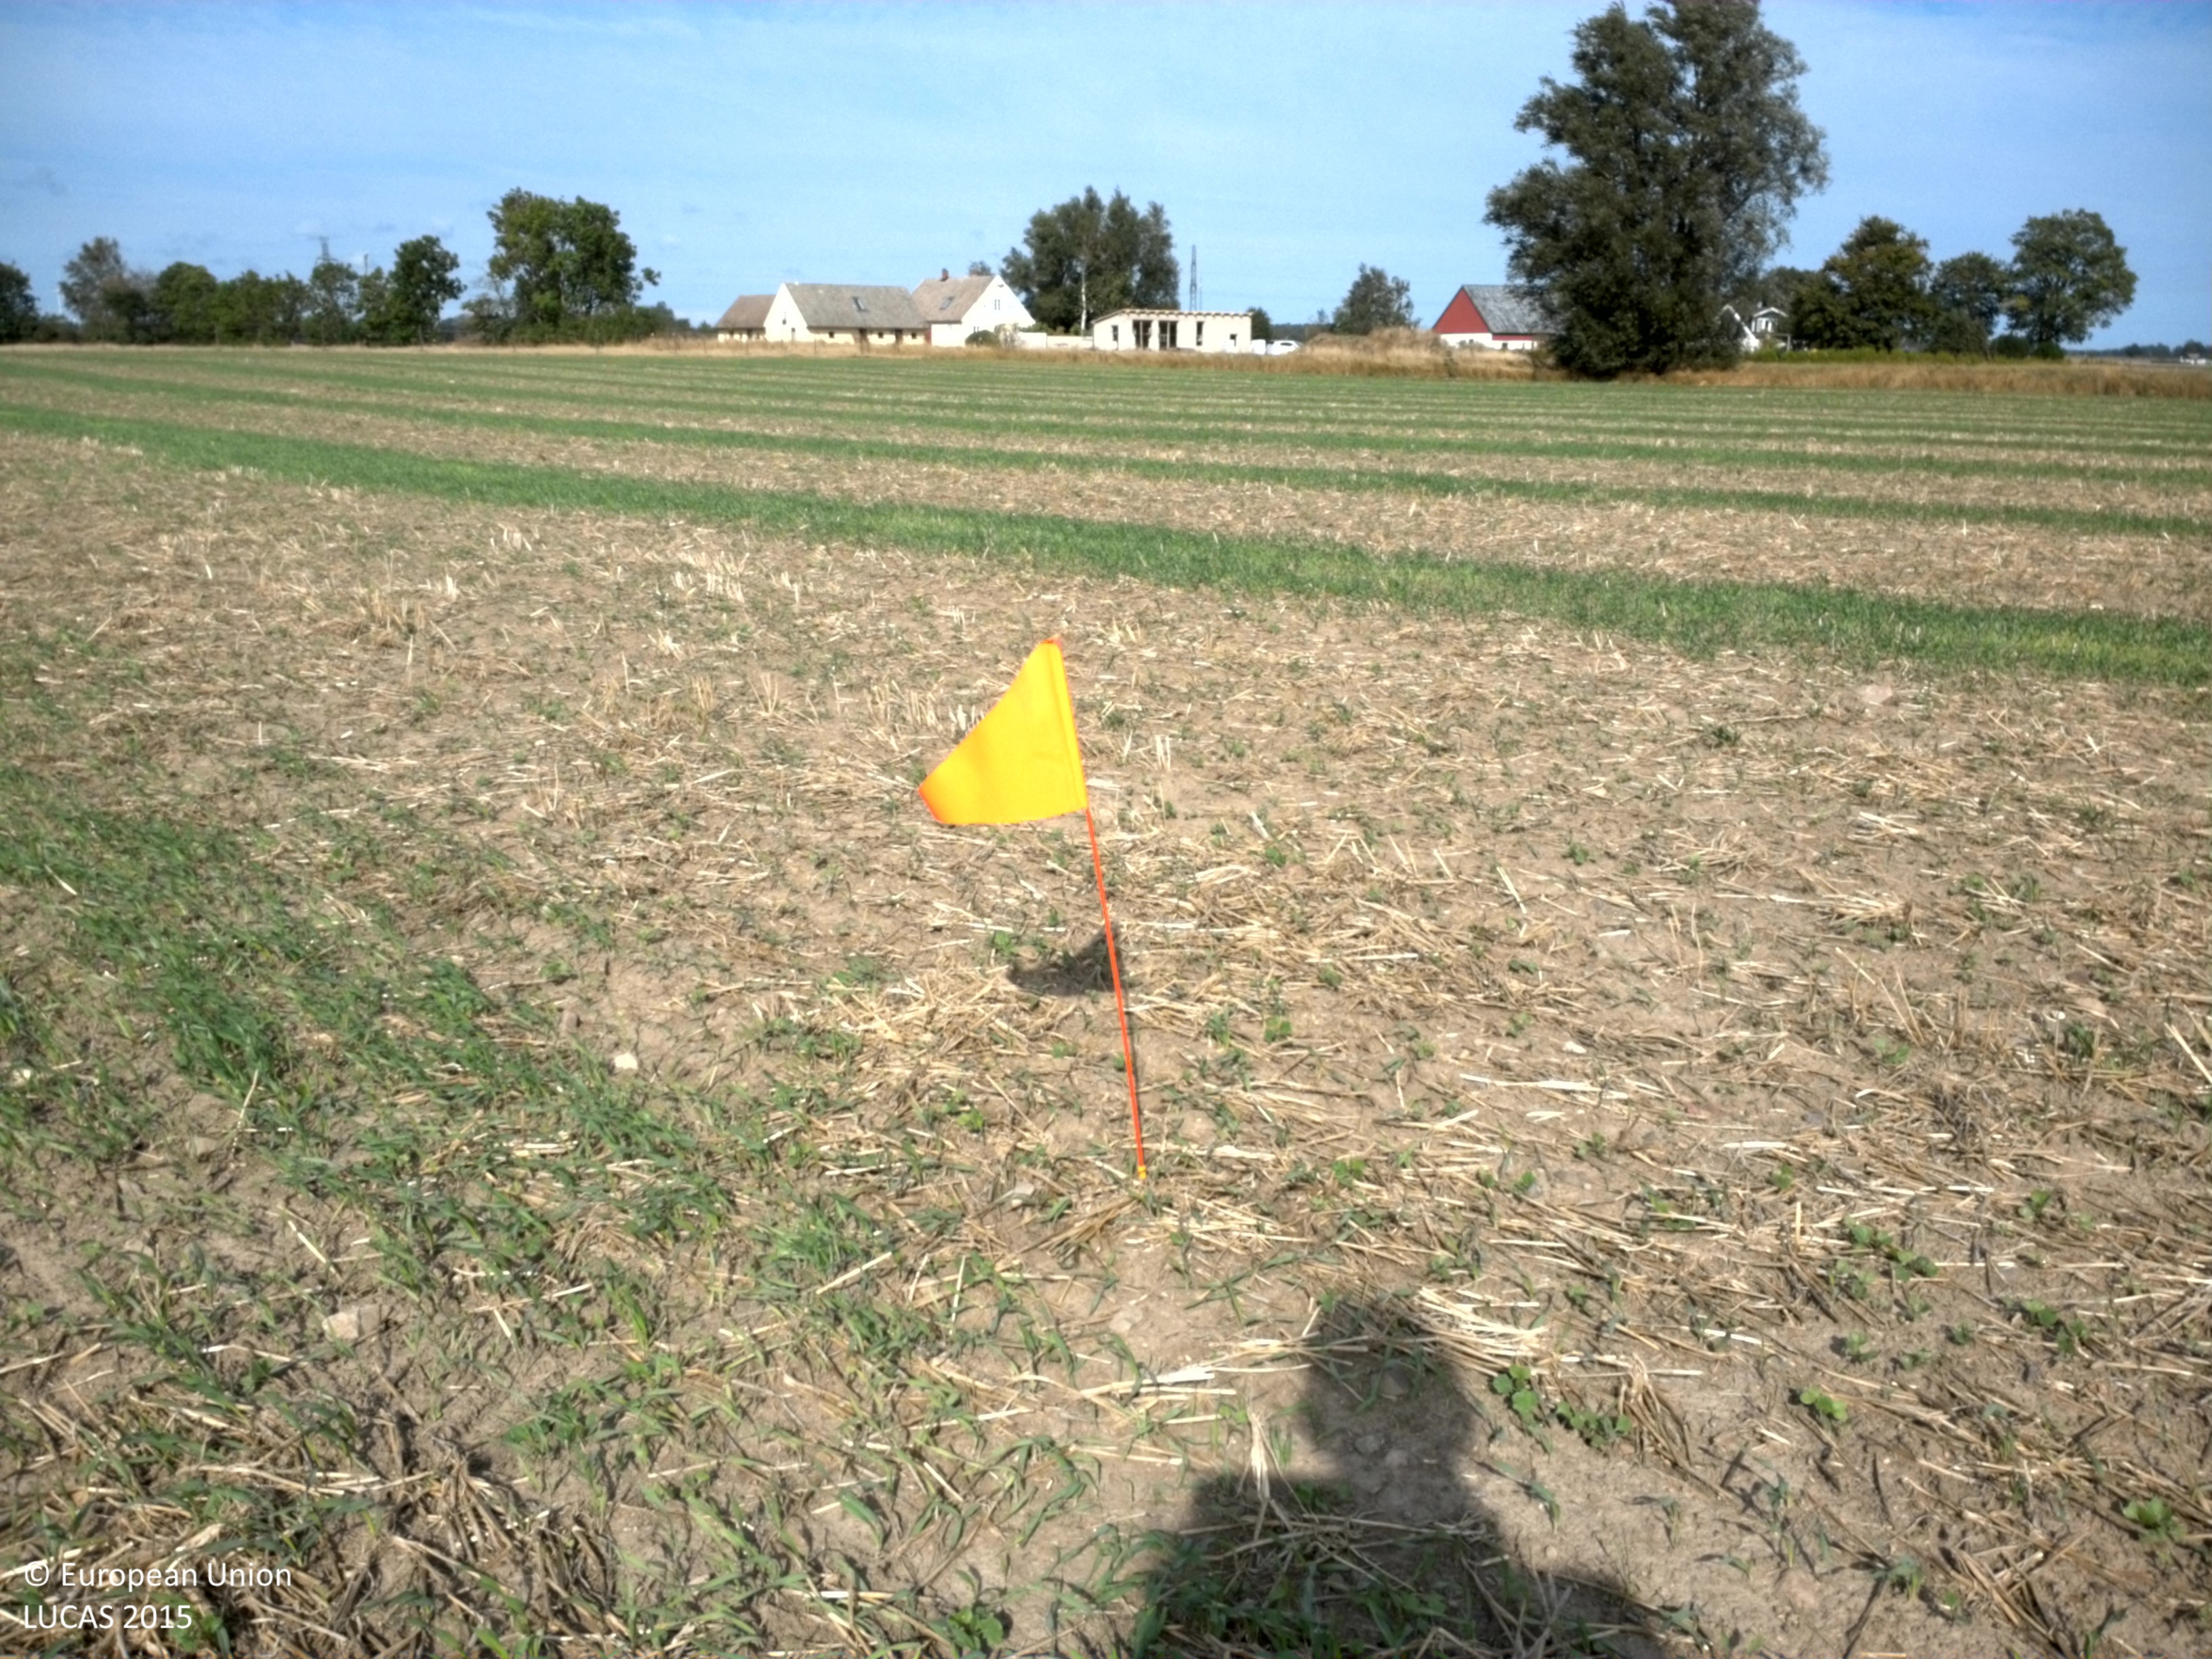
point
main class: Cropland
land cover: Other leguminous and mixtures for fodder
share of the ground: 10 - 25 %
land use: Agriculture (excluding fallow land and kitchen gardens)
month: September
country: SE
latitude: 55.5303
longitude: 14.0384
